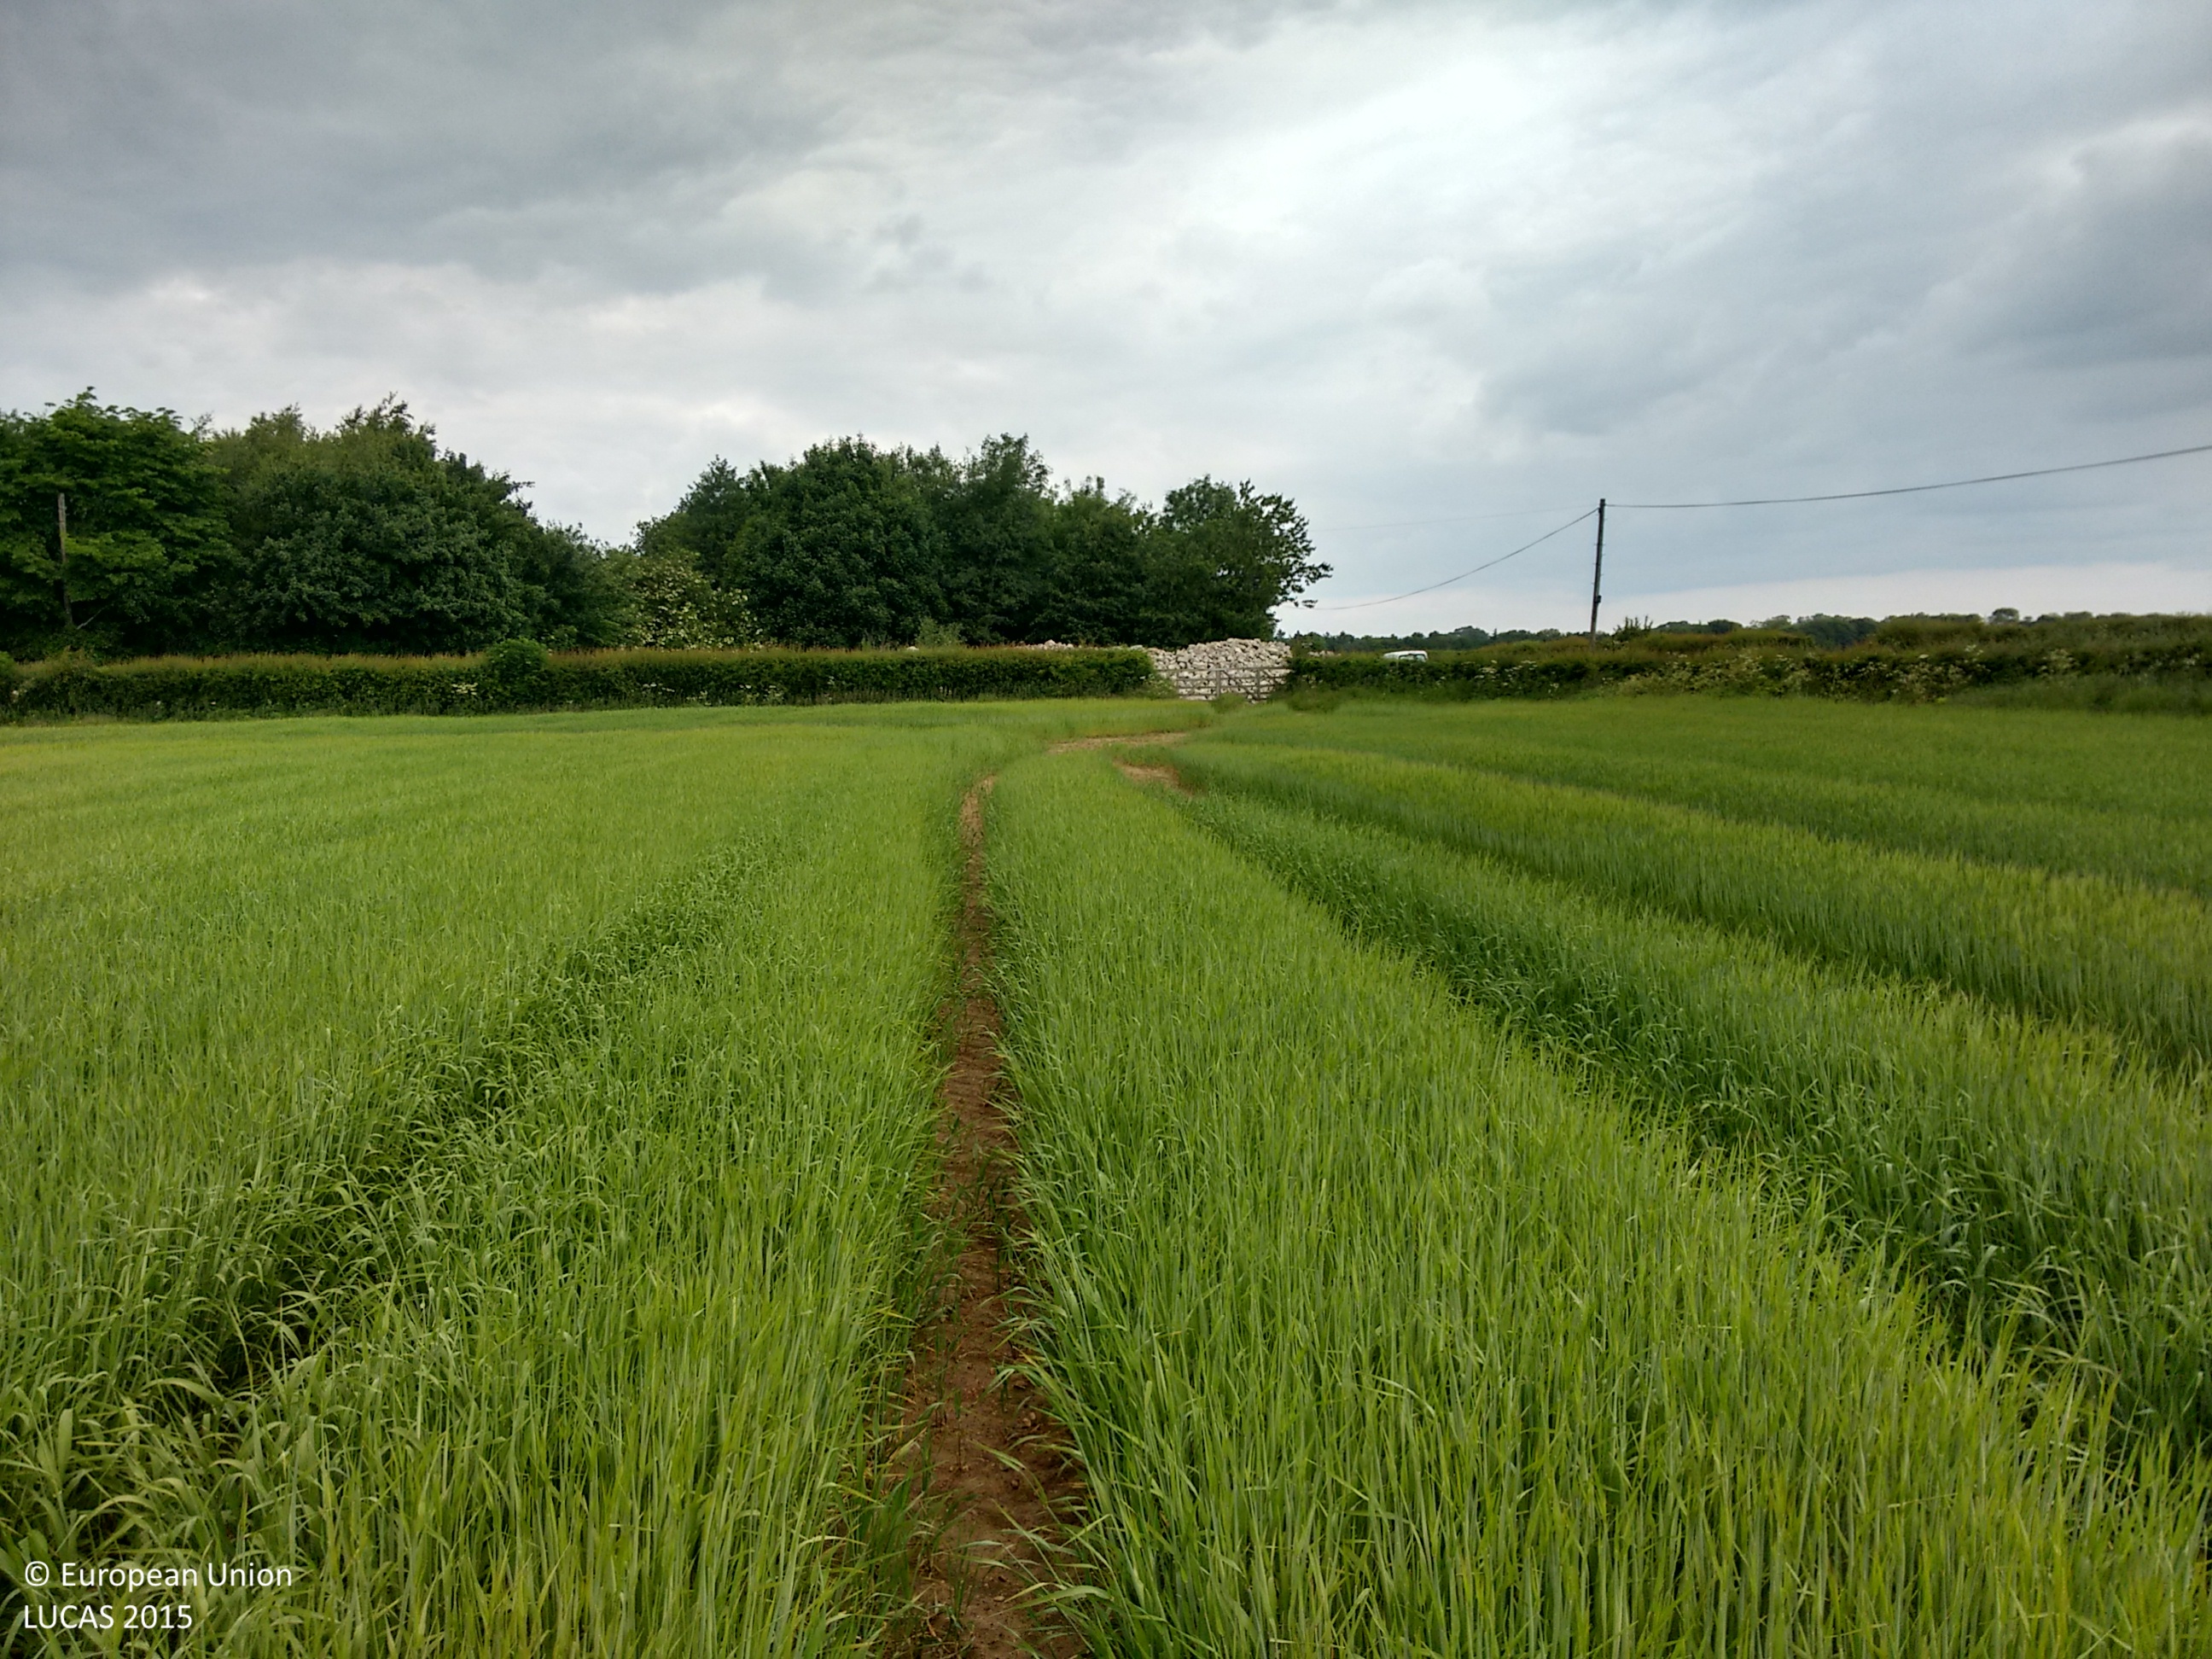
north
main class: Cropland
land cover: Barley
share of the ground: > 75 %
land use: Agriculture (excluding fallow land and kitchen gardens)
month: June
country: GB
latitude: 54.1757
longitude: -0.9342
